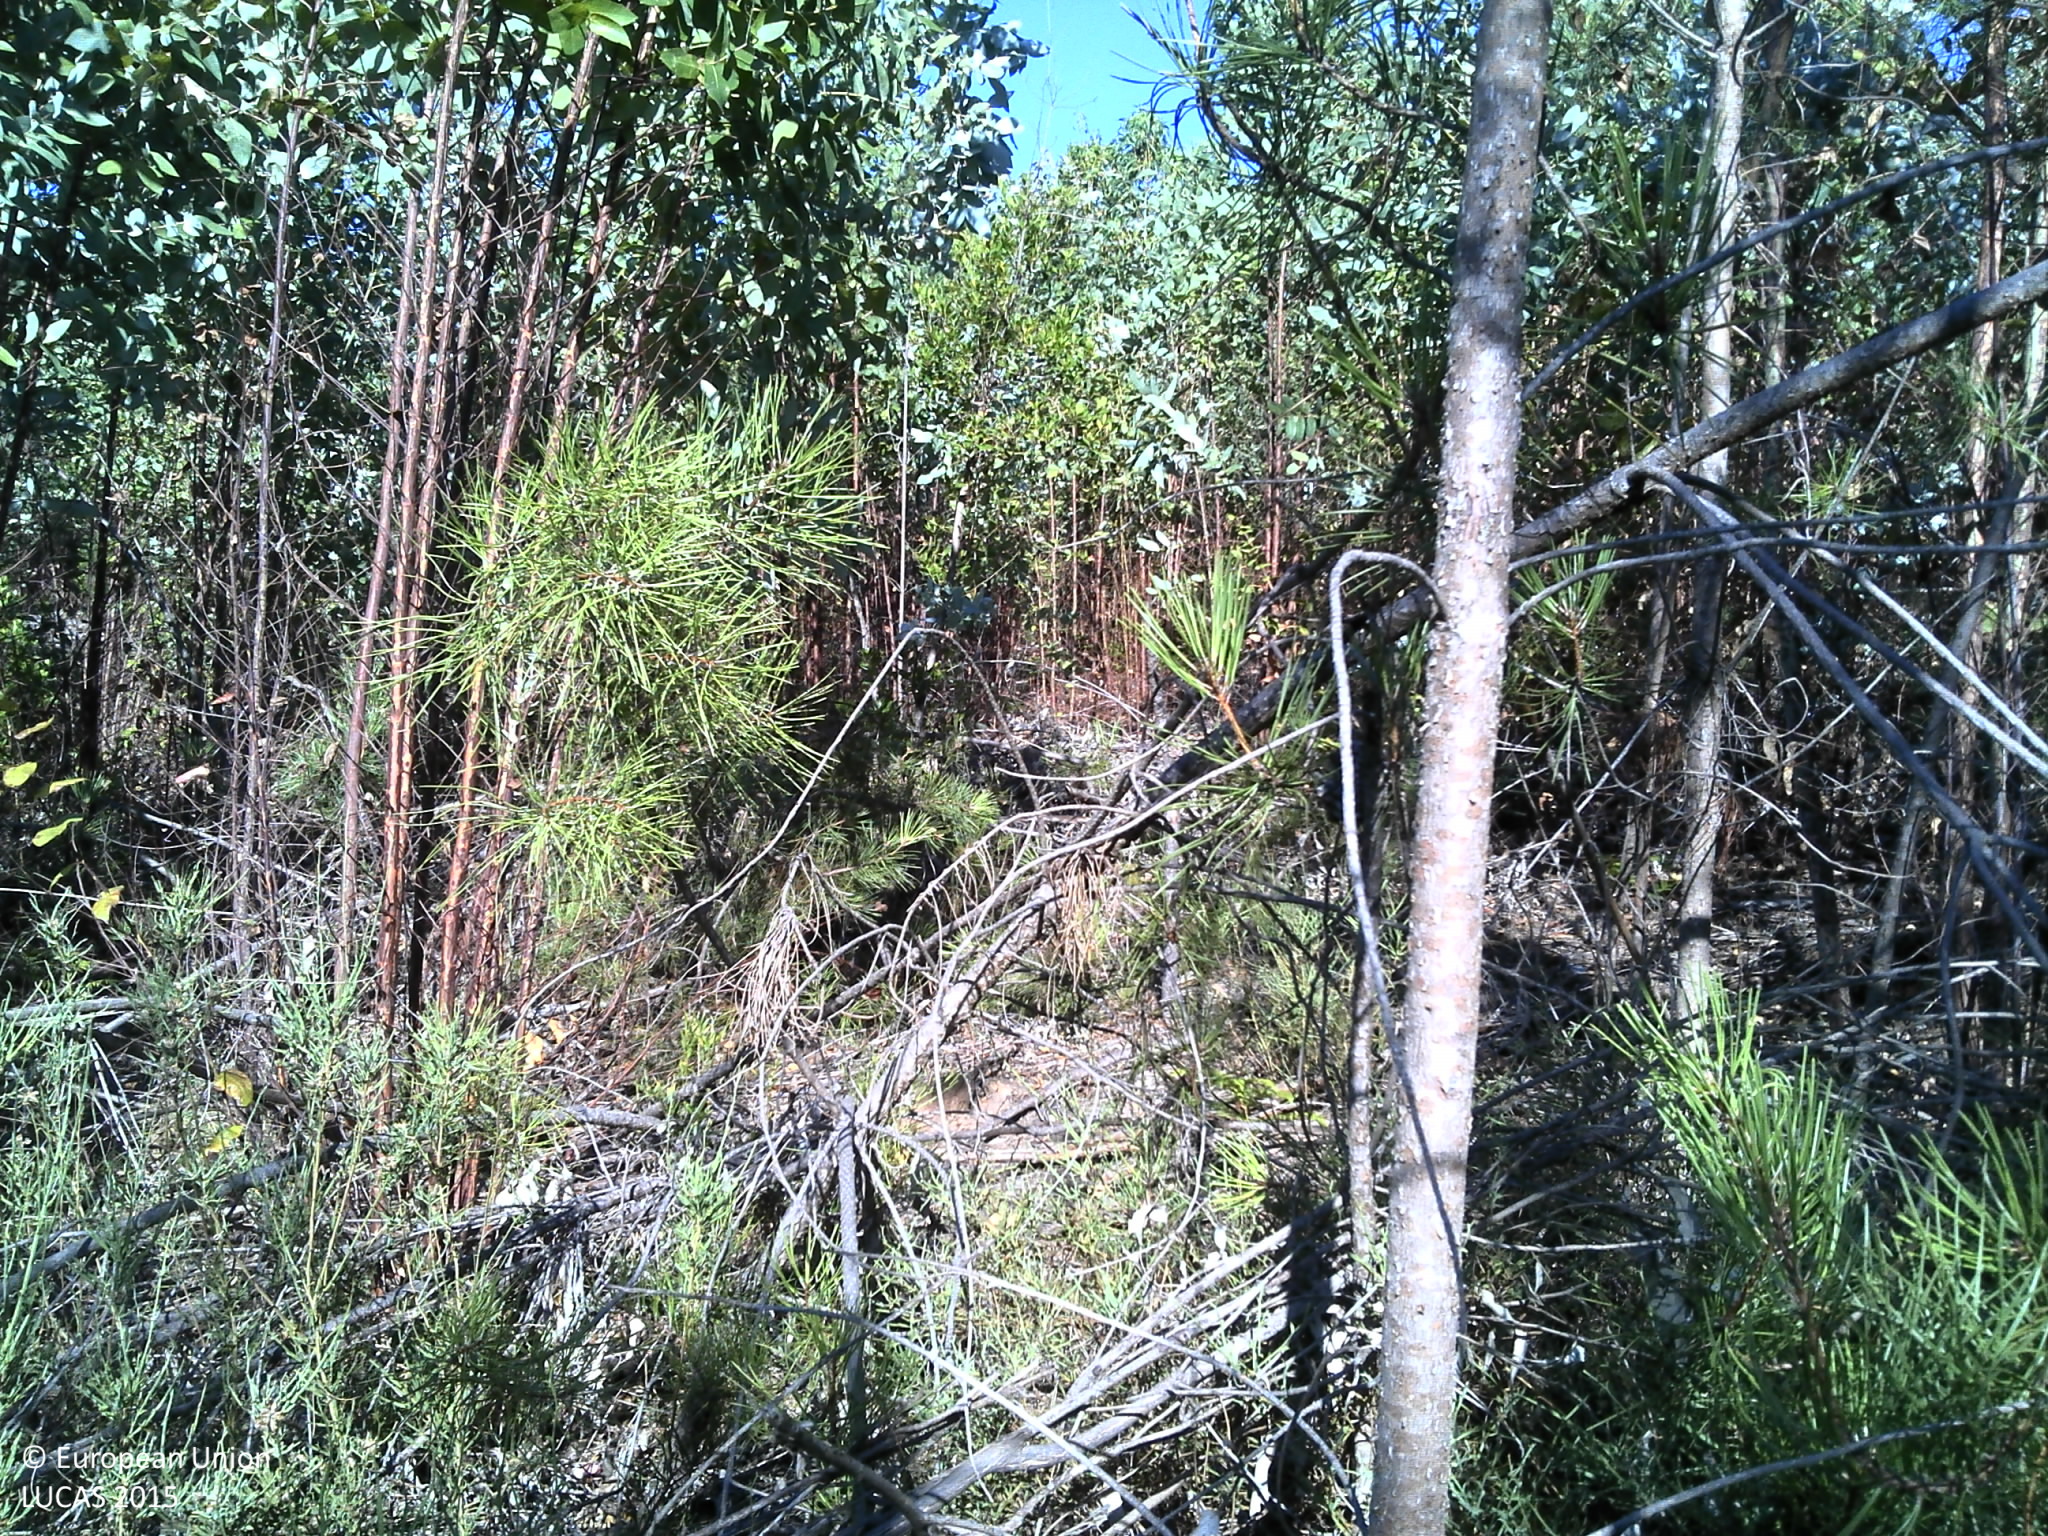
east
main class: Woodland
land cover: Broadleaved woodland
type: exotic forest
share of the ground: 10 - 25 %
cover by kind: shrubs 50 %, unconsolidated bare surface 30 %, broadleaved forest trees 15 %, coniferous forest trees 5 %
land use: Forestry
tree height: < 5 m
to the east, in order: Broadleaved woodland; Tracks; Broadleaved woodland; Pine dominated coniferous woodland; Tracks; Pine dominated coniferous woodland; Tracks; Broadleaved woodland
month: July
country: PT
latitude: 39.8386
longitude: -8.0272
